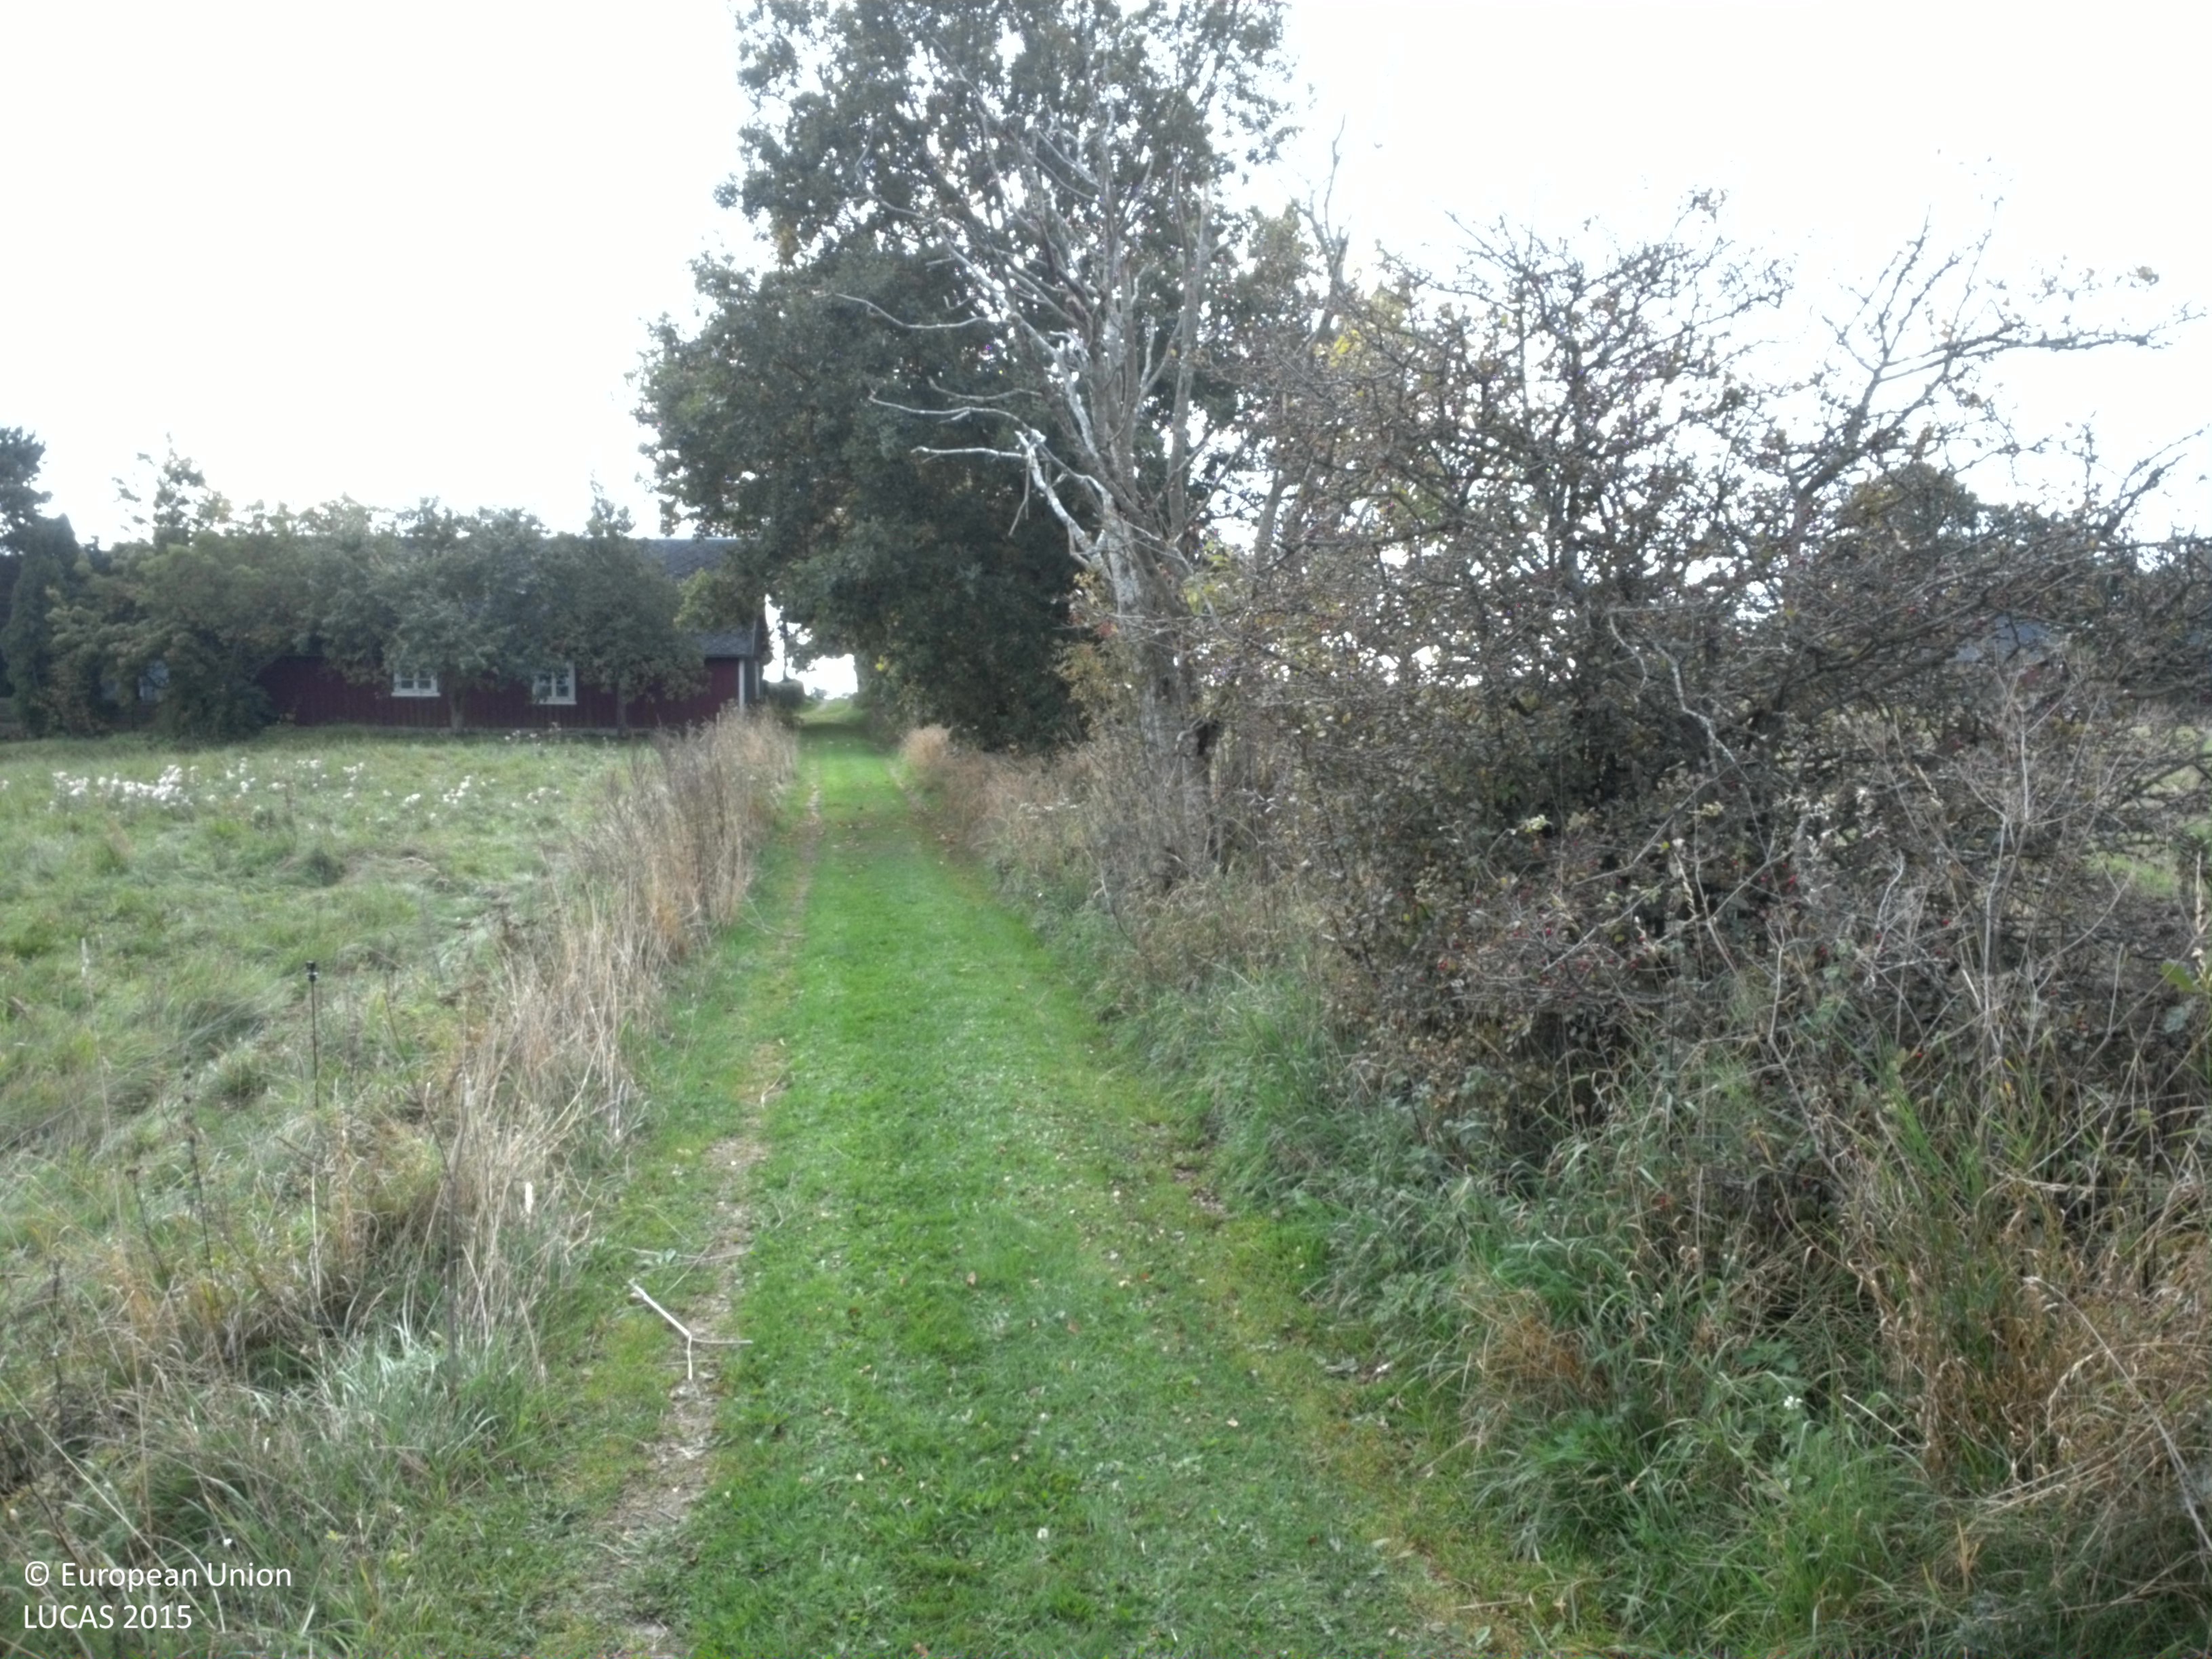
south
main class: Grassland
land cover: Grassland without tree/shrub cover
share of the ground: > 75 %
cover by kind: herbaceous plants 100 %
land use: Agriculture (excluding fallow land and kitchen gardens)
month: October
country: SE
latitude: 55.7383
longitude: 13.7091
